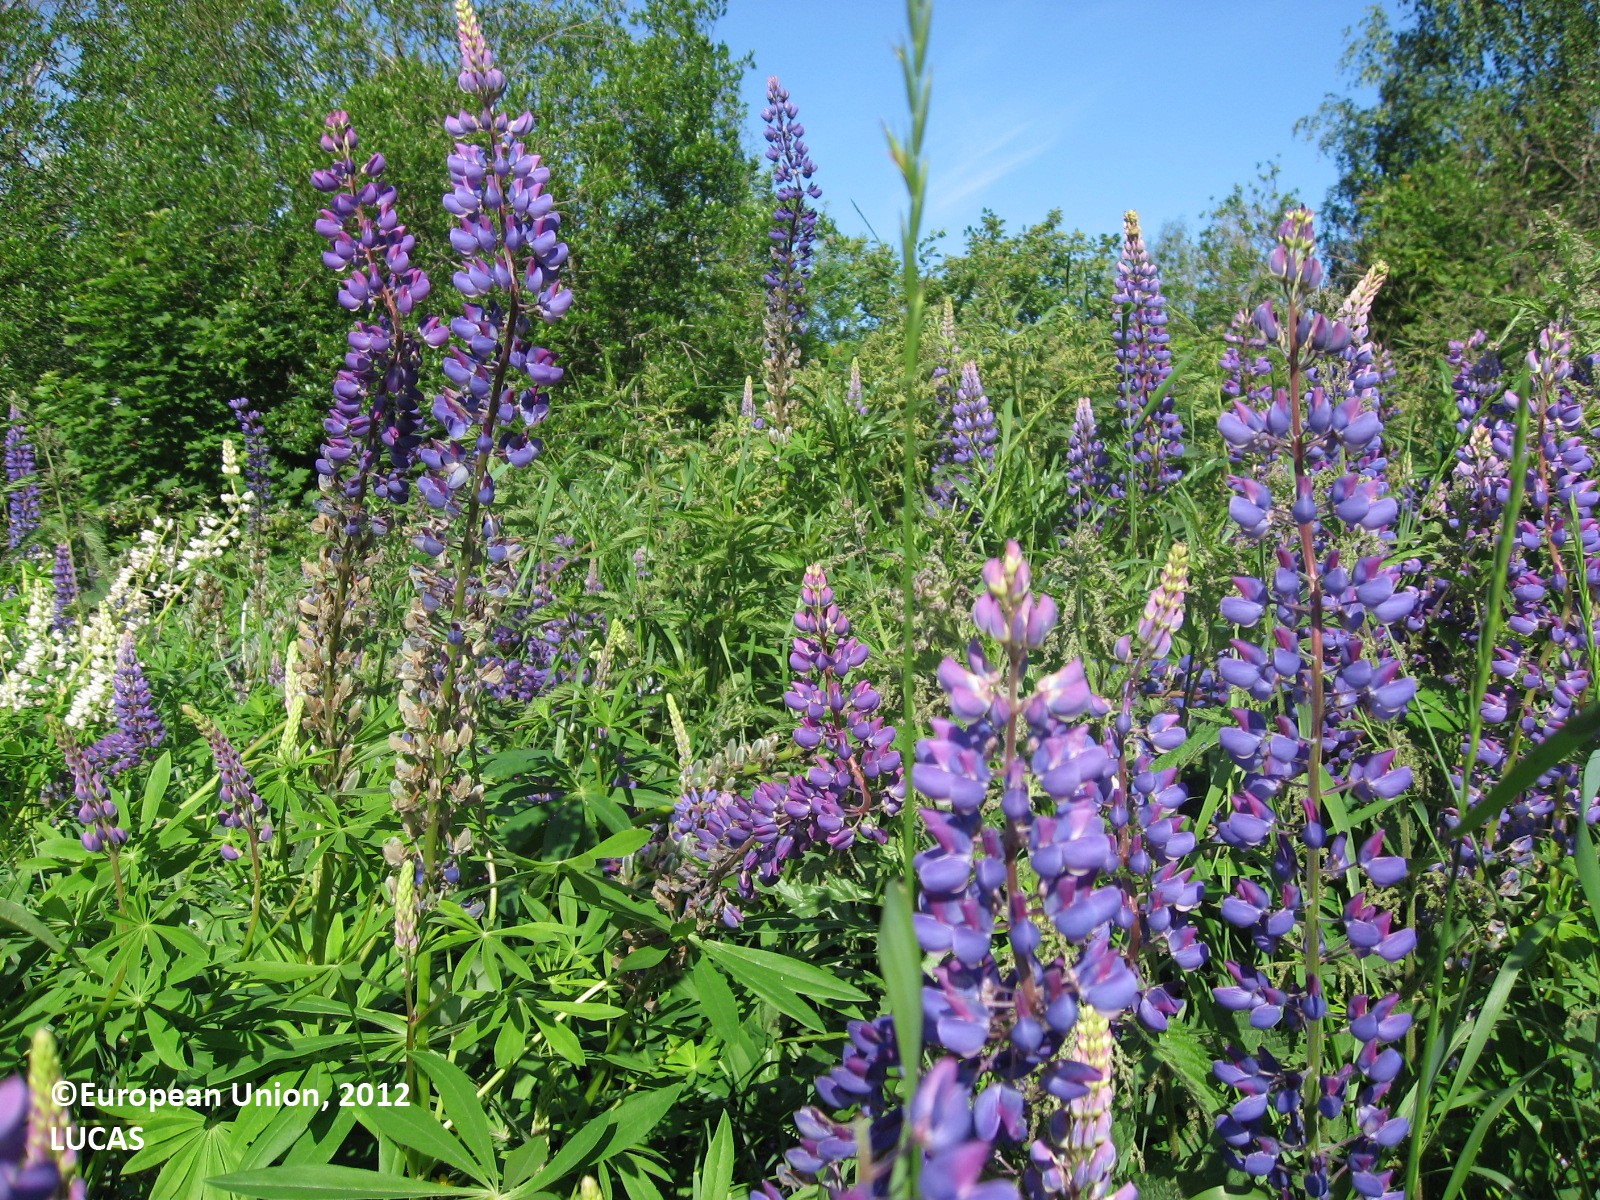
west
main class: Grassland
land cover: Spontaneously vegetated surfaces
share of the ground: > 75 %
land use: Semi-natural and natural areas not in use
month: June
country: FI
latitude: 60.4301
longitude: 26.2262
